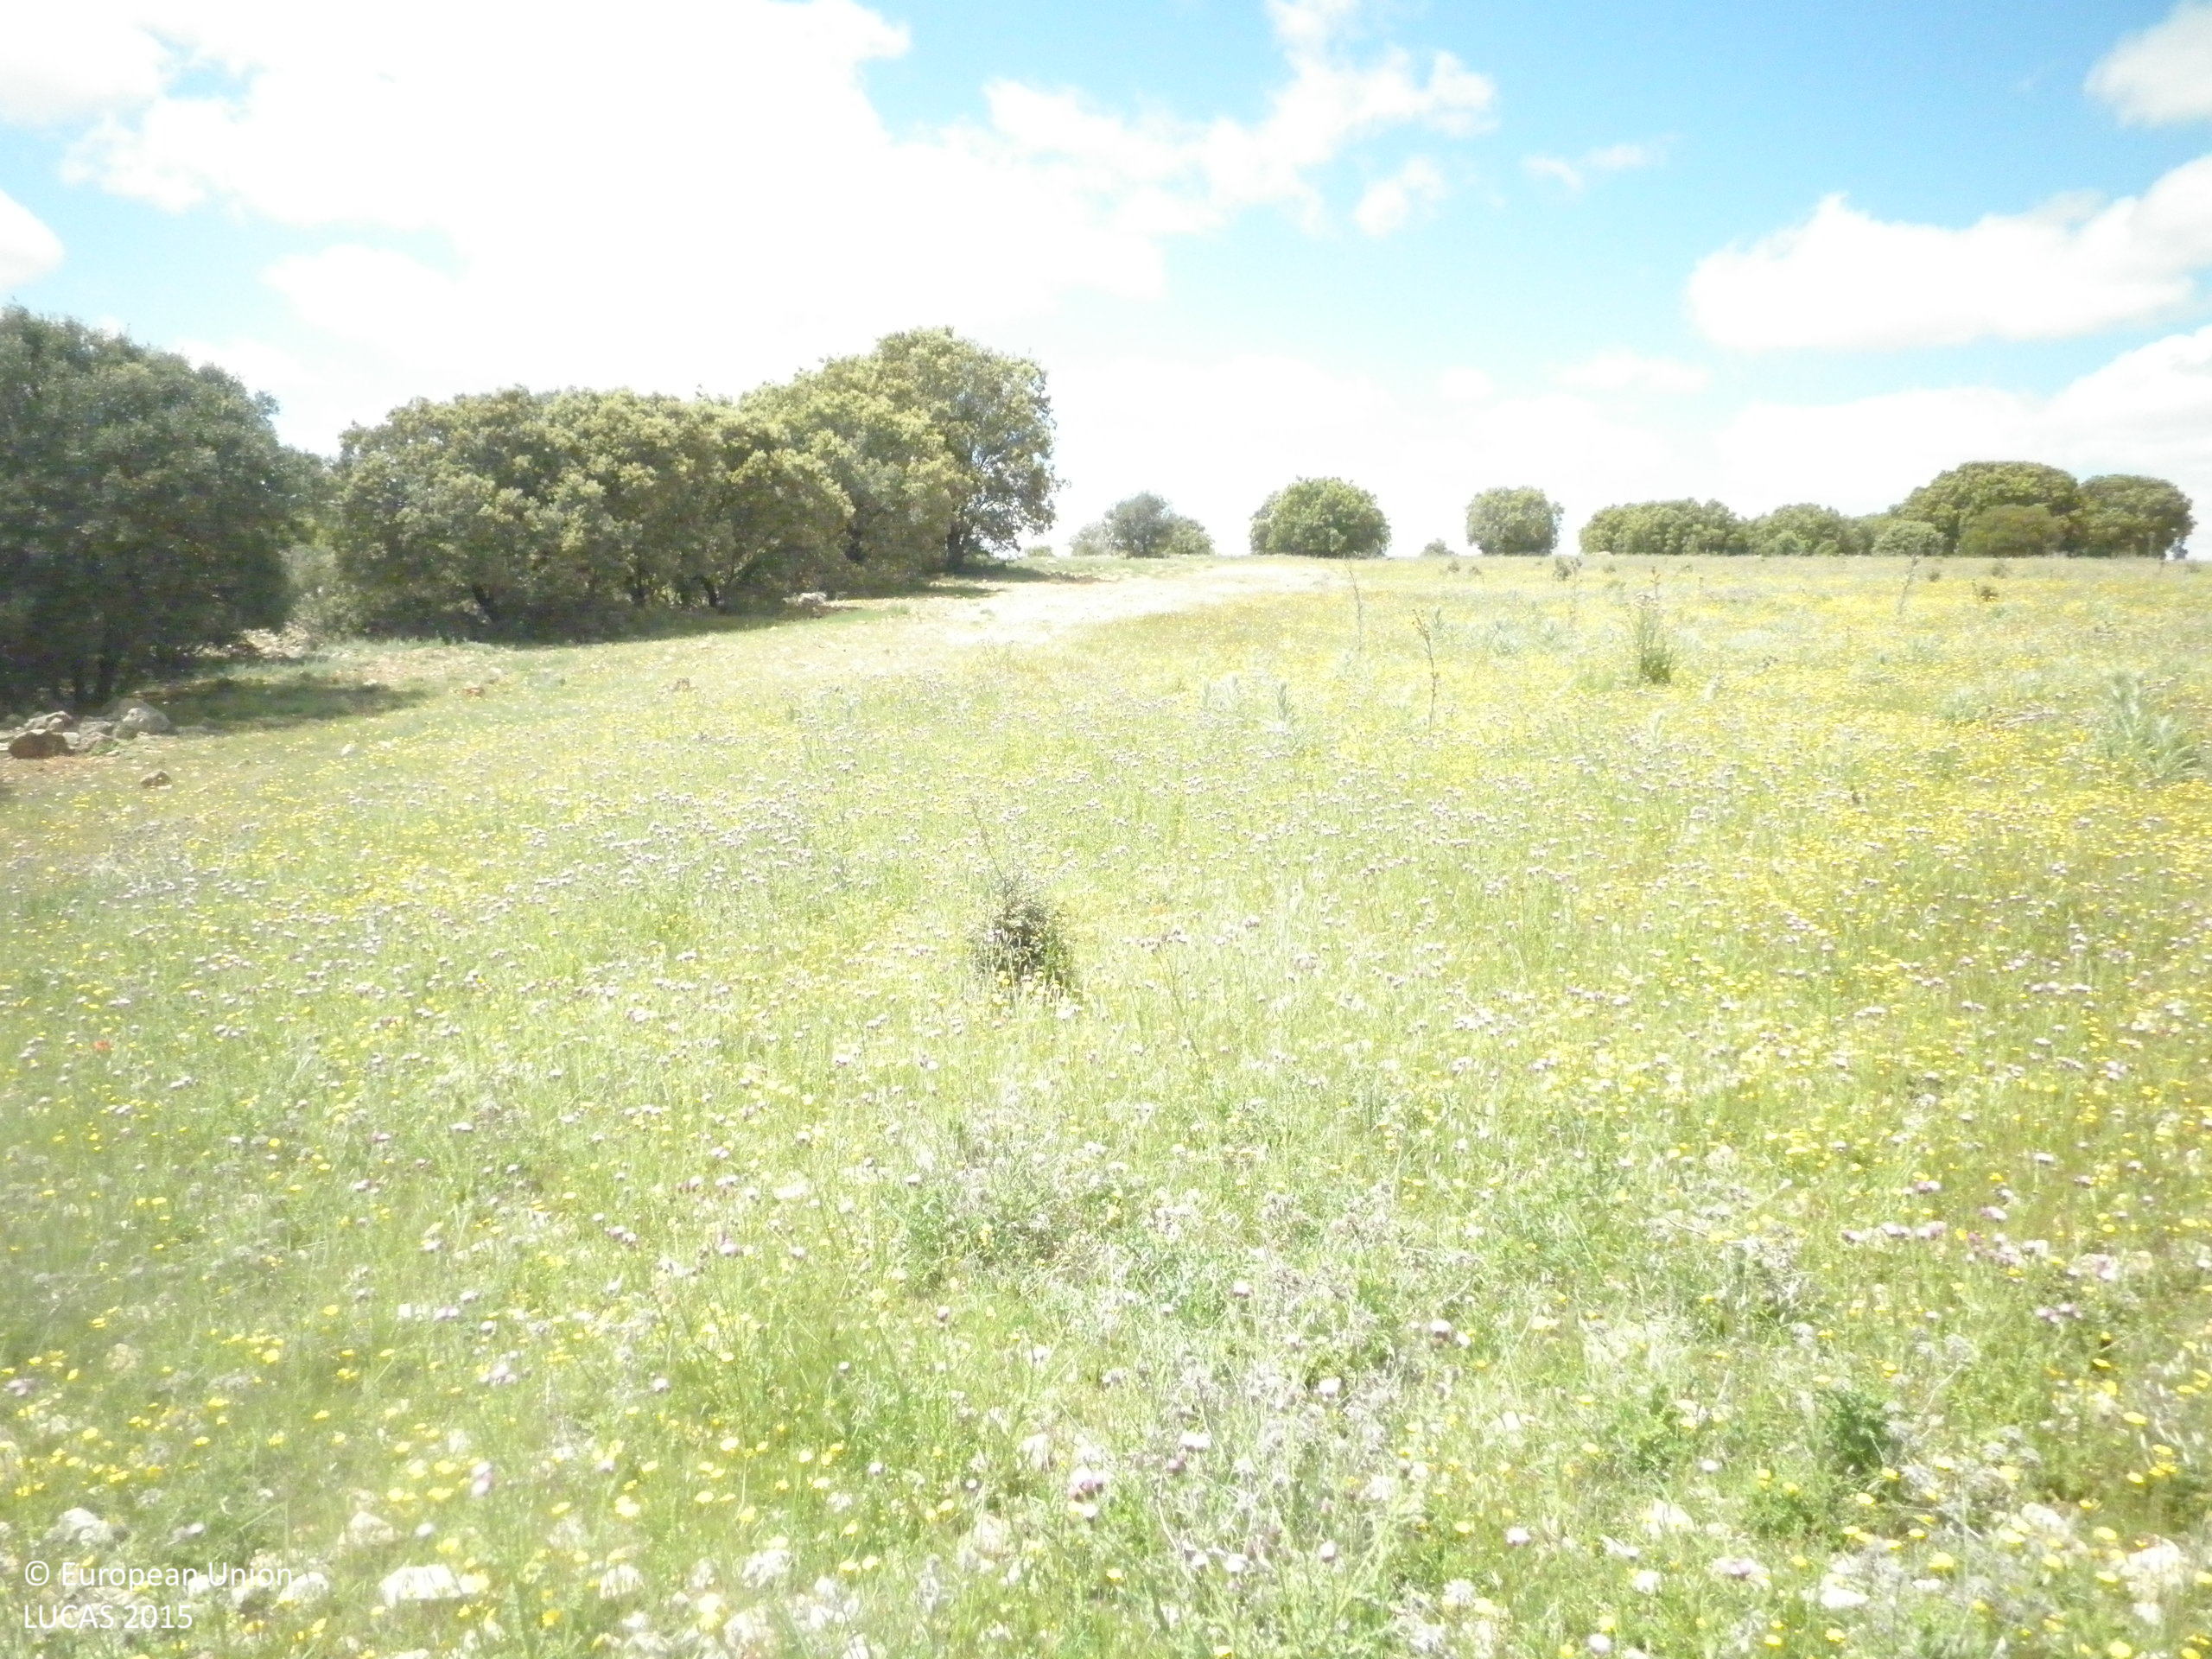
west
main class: Grassland
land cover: Spontaneously vegetated surfaces
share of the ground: > 75 %
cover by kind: herbaceous plants 60 %, unconsolidated bare surface 35 %, shrubs 5 %
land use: Semi-natural and natural areas not in use
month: May
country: ES
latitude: 39.6951
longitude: -2.8340
